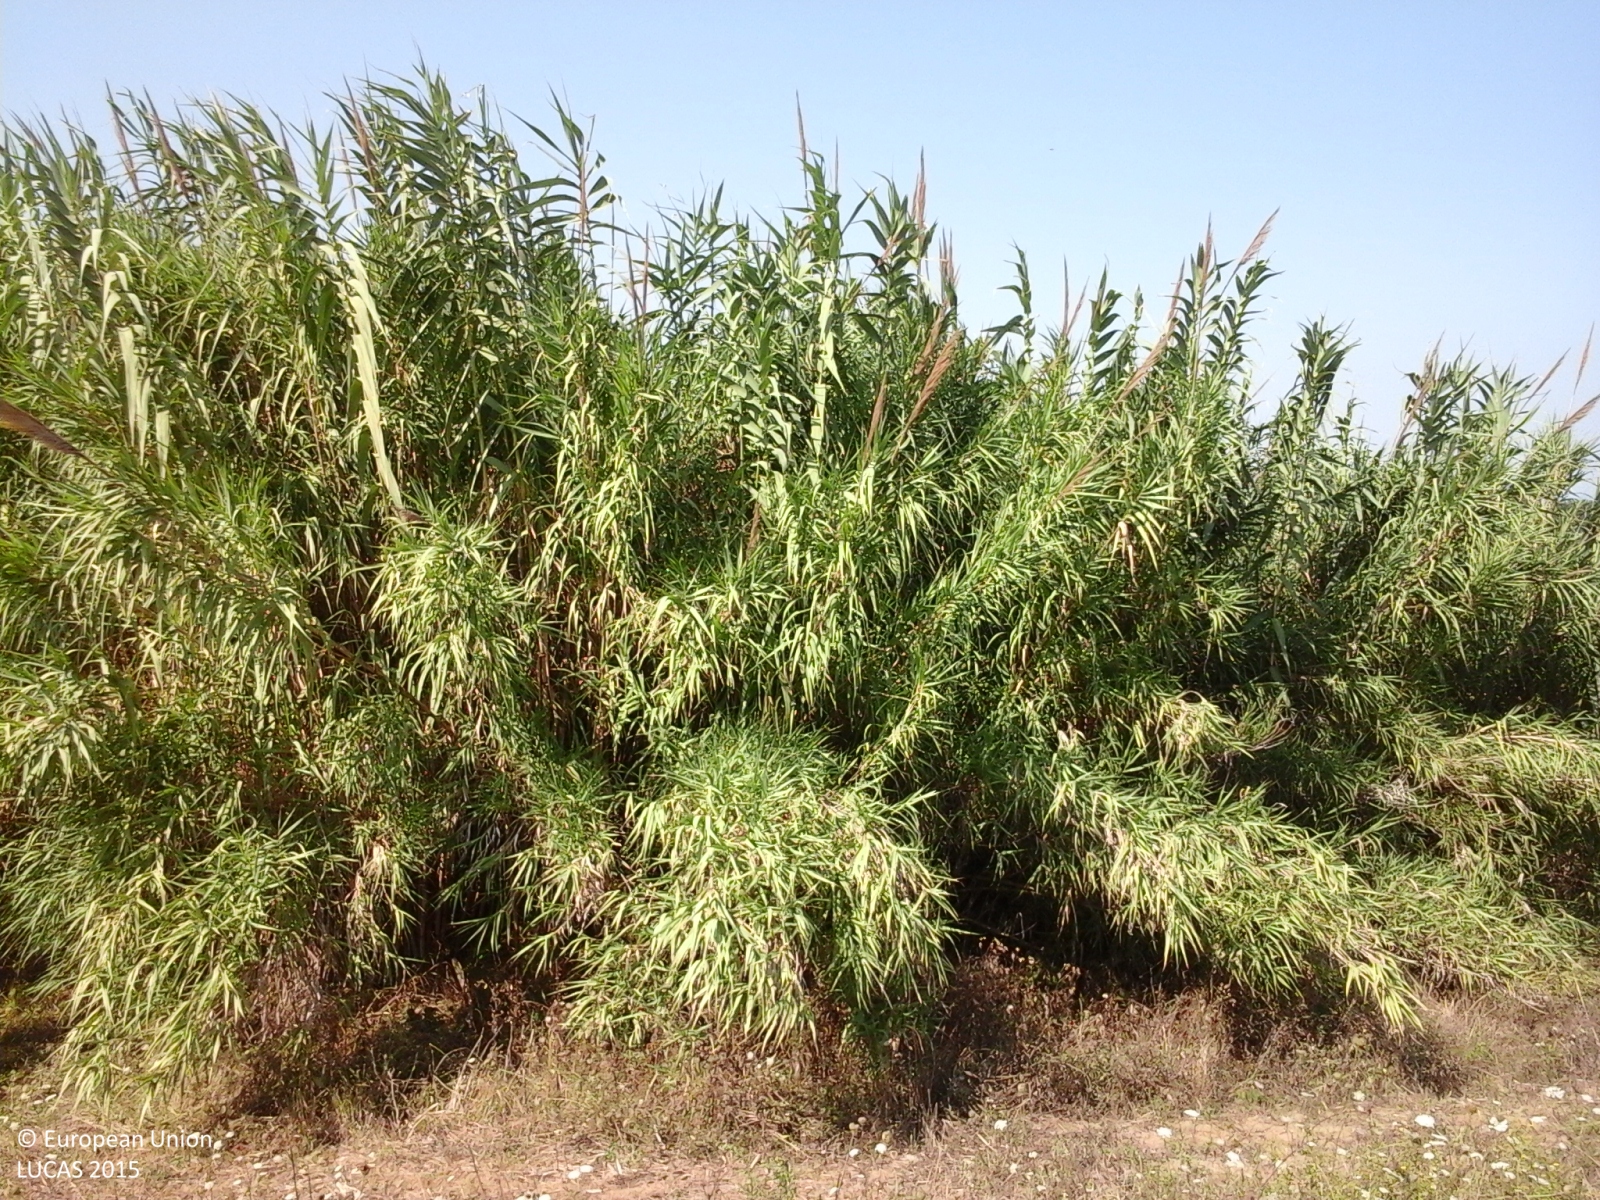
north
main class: Cropland
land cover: Nuts trees
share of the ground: < 10 %
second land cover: Spontaneously vegetated surfaces
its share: > 75 %
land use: Agriculture (excluding fallow land and kitchen gardens)
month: August
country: IT
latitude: 42.6710
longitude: 13.8568
